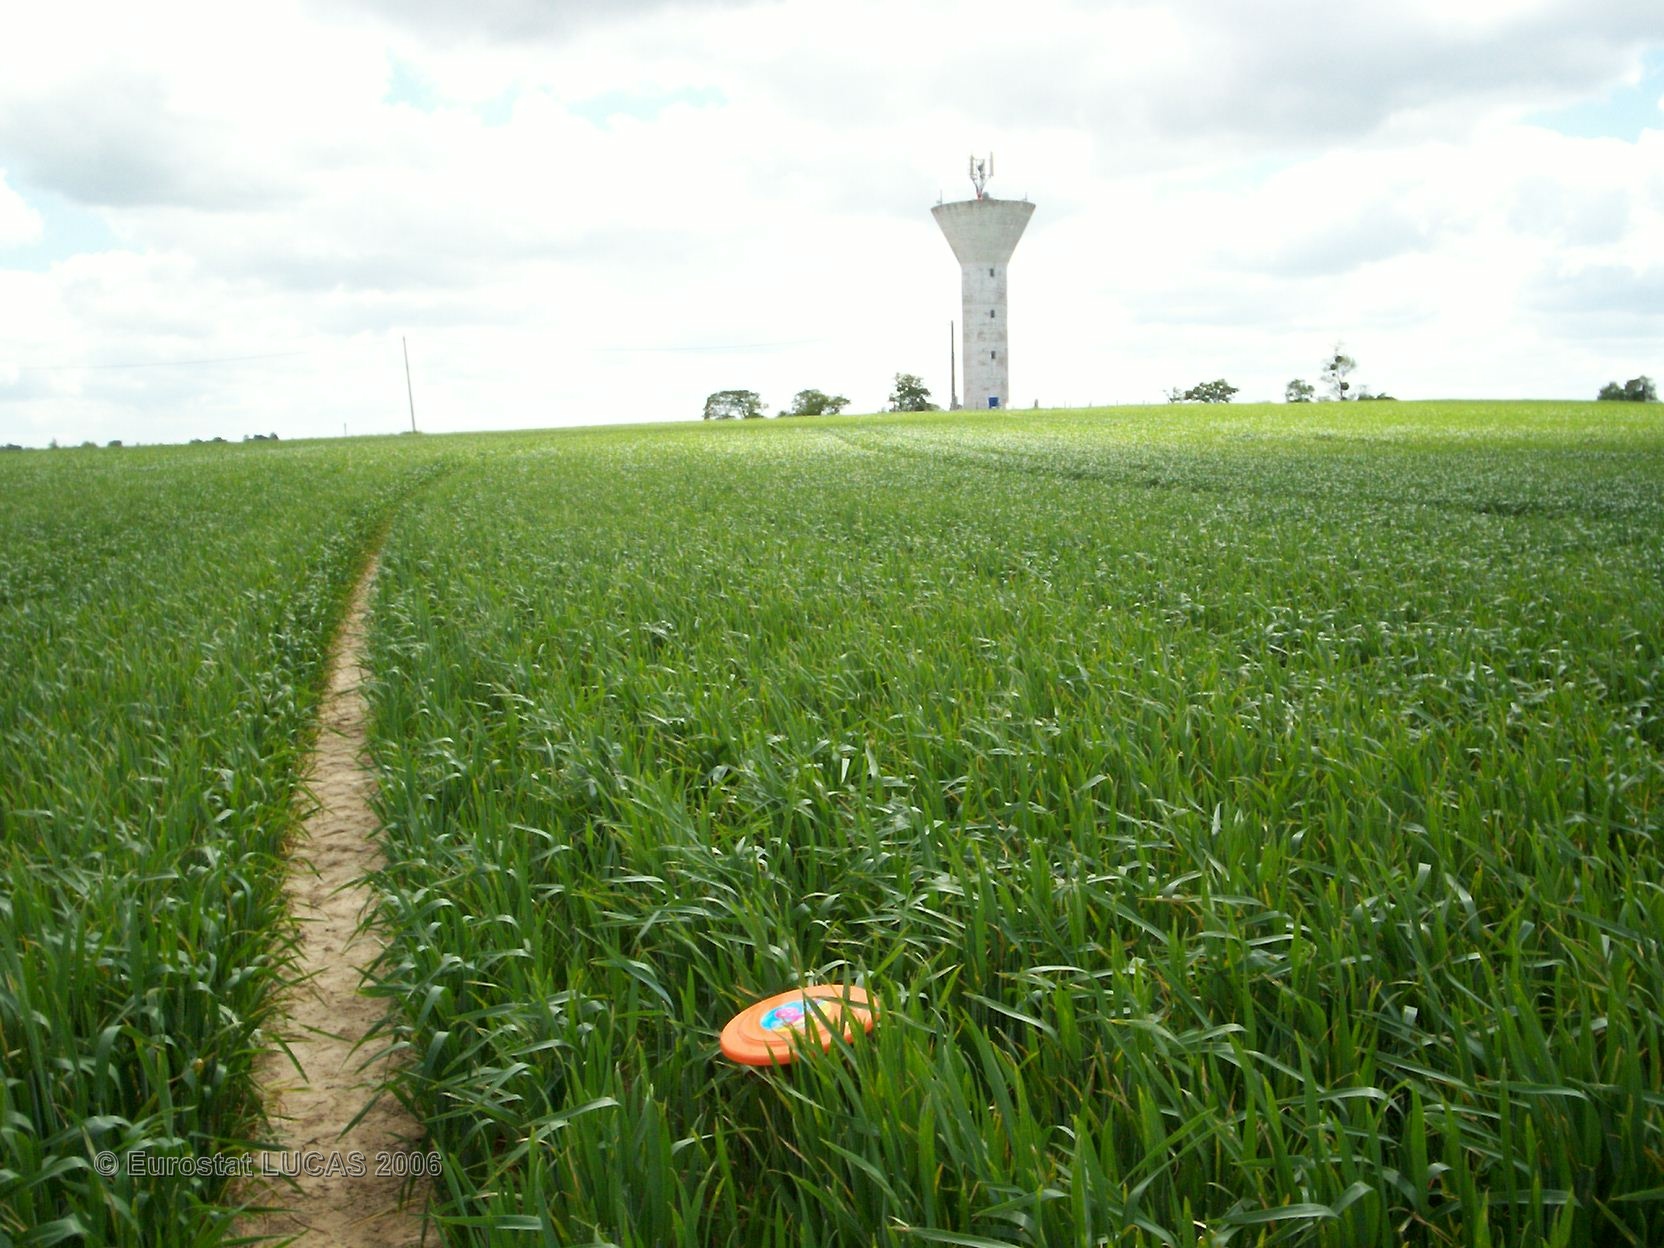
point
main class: Cropland
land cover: Common wheat
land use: Agriculture (excluding fallow land and kitchen gardens)
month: May
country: FR
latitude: 48.5374
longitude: -2.8942
